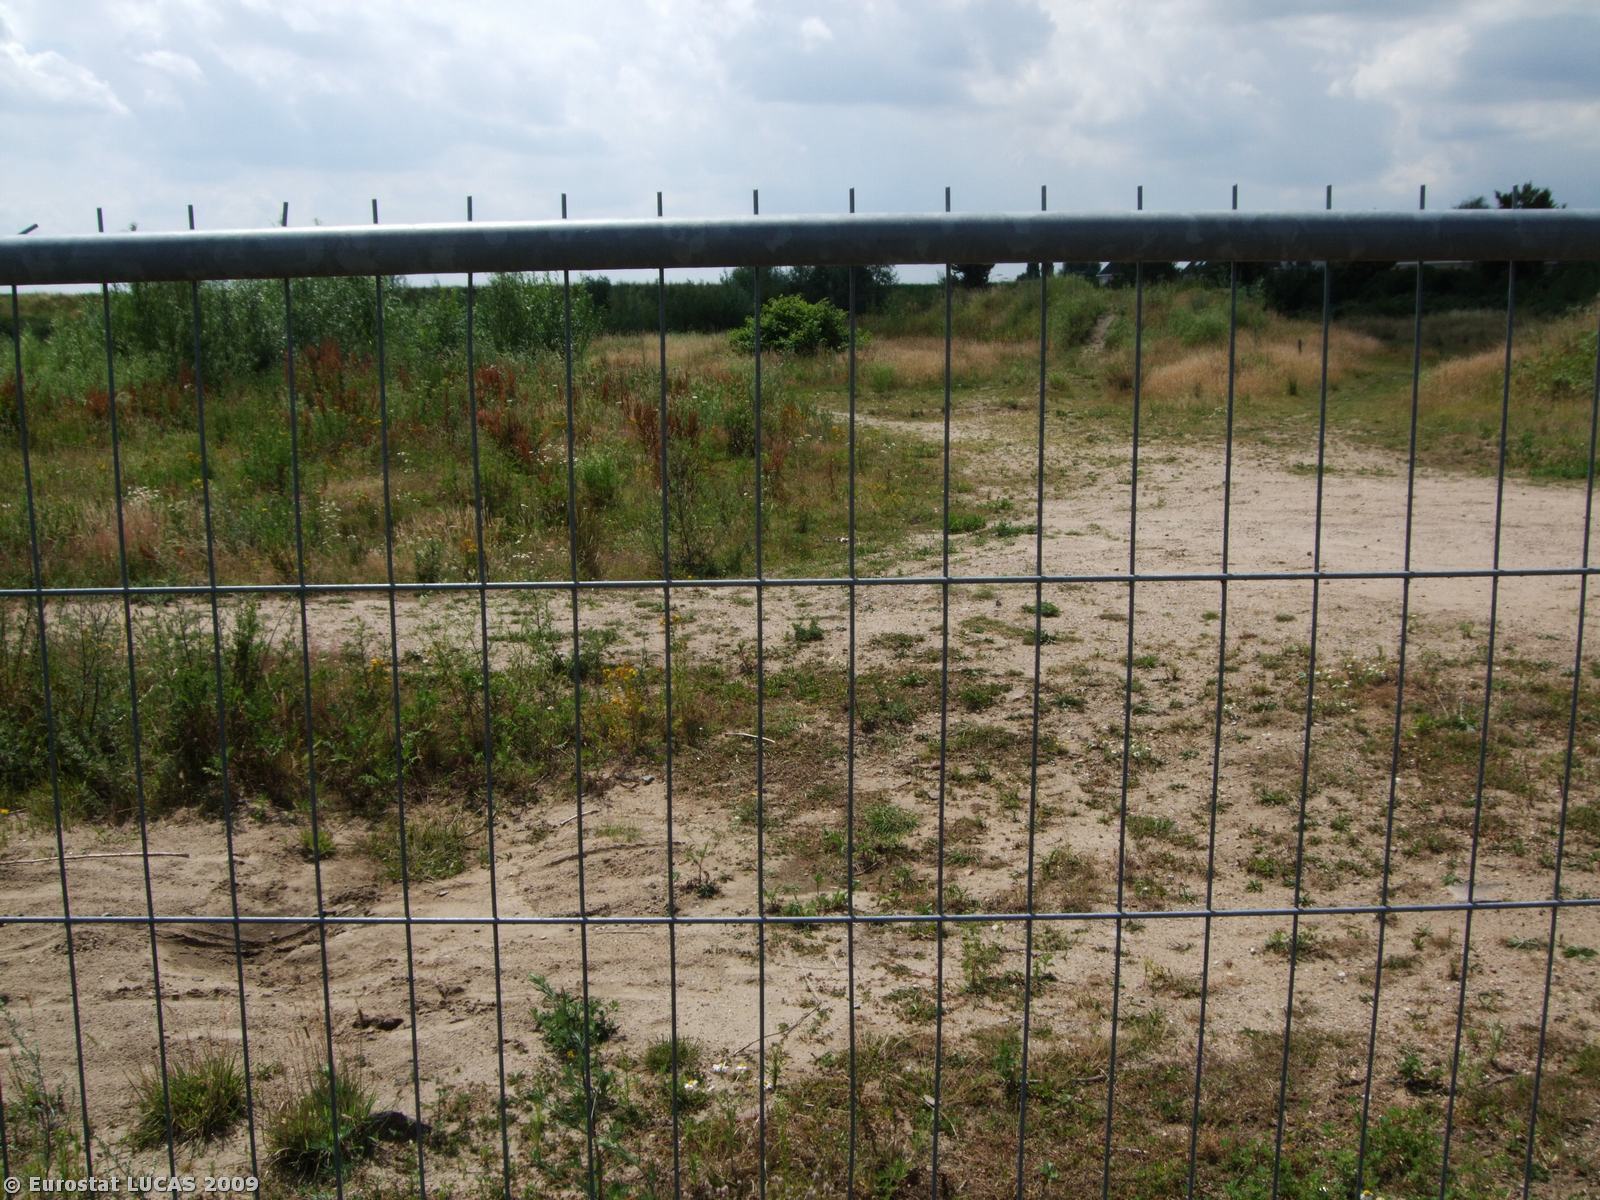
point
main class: Grassland
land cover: Spontaneously vegetated surfaces
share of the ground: 50 - 75 %
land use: Unused
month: July
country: NL
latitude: 51.8942
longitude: 5.4498
